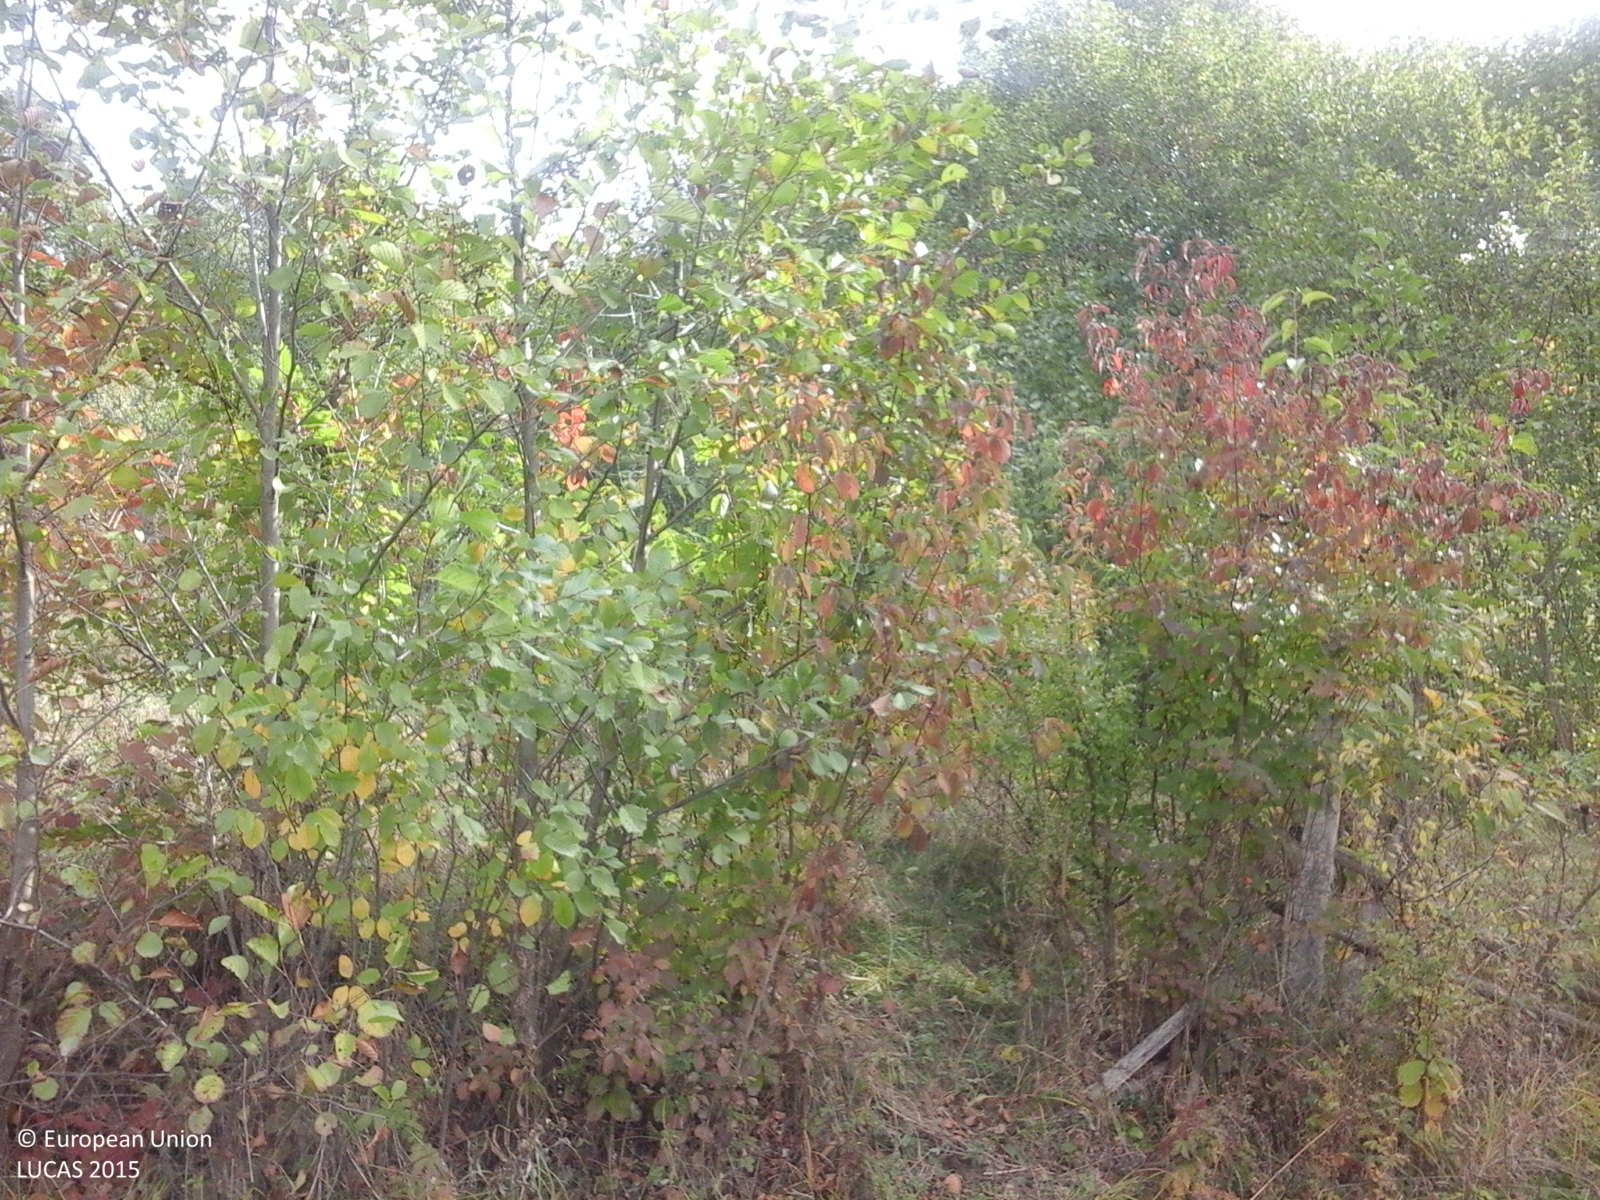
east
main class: Grassland
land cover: Grassland without tree/shrub cover
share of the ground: > 75 %
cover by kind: herbaceous plants 100 %
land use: Agriculture (excluding fallow land and kitchen gardens)
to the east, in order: Grassland without tree/shrub cover; Tracks; Broadleaved woodland; Grassland without tree/shrub cover; Abandoned hedges; Grassland without tree/shrub cover; Abandoned hedges; Grassland without tree/shrub cover; Abandoned hedges; Spontaneously vegetated surfaces; Abandoned hedges; Fences; Grassland without tree/shrub cover
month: October
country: RO
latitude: 46.4194
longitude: 25.3937
